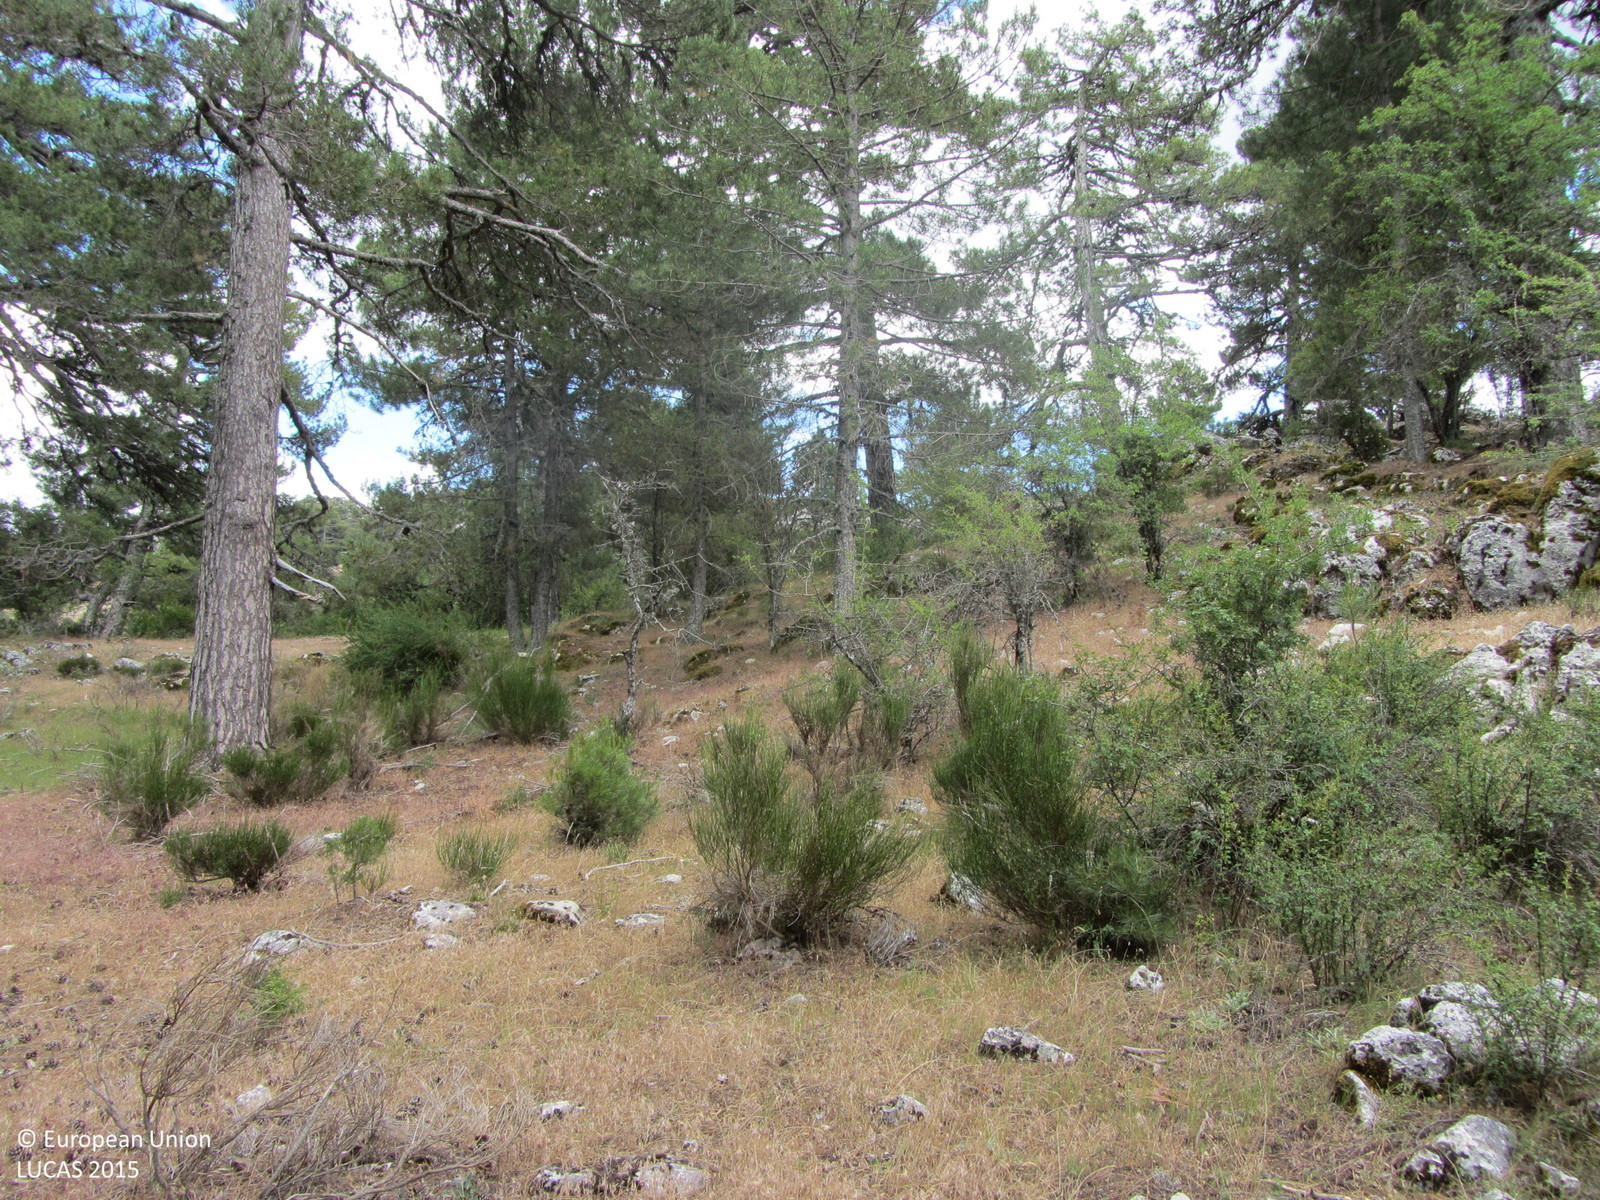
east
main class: Woodland
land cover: Pine dominated coniferous woodland
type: coniferous forest of the mediterranean region
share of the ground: 50 - 75 %
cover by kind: coniferous forest trees 70 %, shrubs 15 %, herbaceous plants 15 %
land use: Forestry
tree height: > 5 m
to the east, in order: Pine dominated coniferous woodland; Shrubland with sparse tree cover; Pine dominated coniferous woodland; Rivers and streams; Pine dominated coniferous woodland; Fences; Pine dominated coniferous woodland
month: June
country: ES
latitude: 37.9426
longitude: -2.7953
